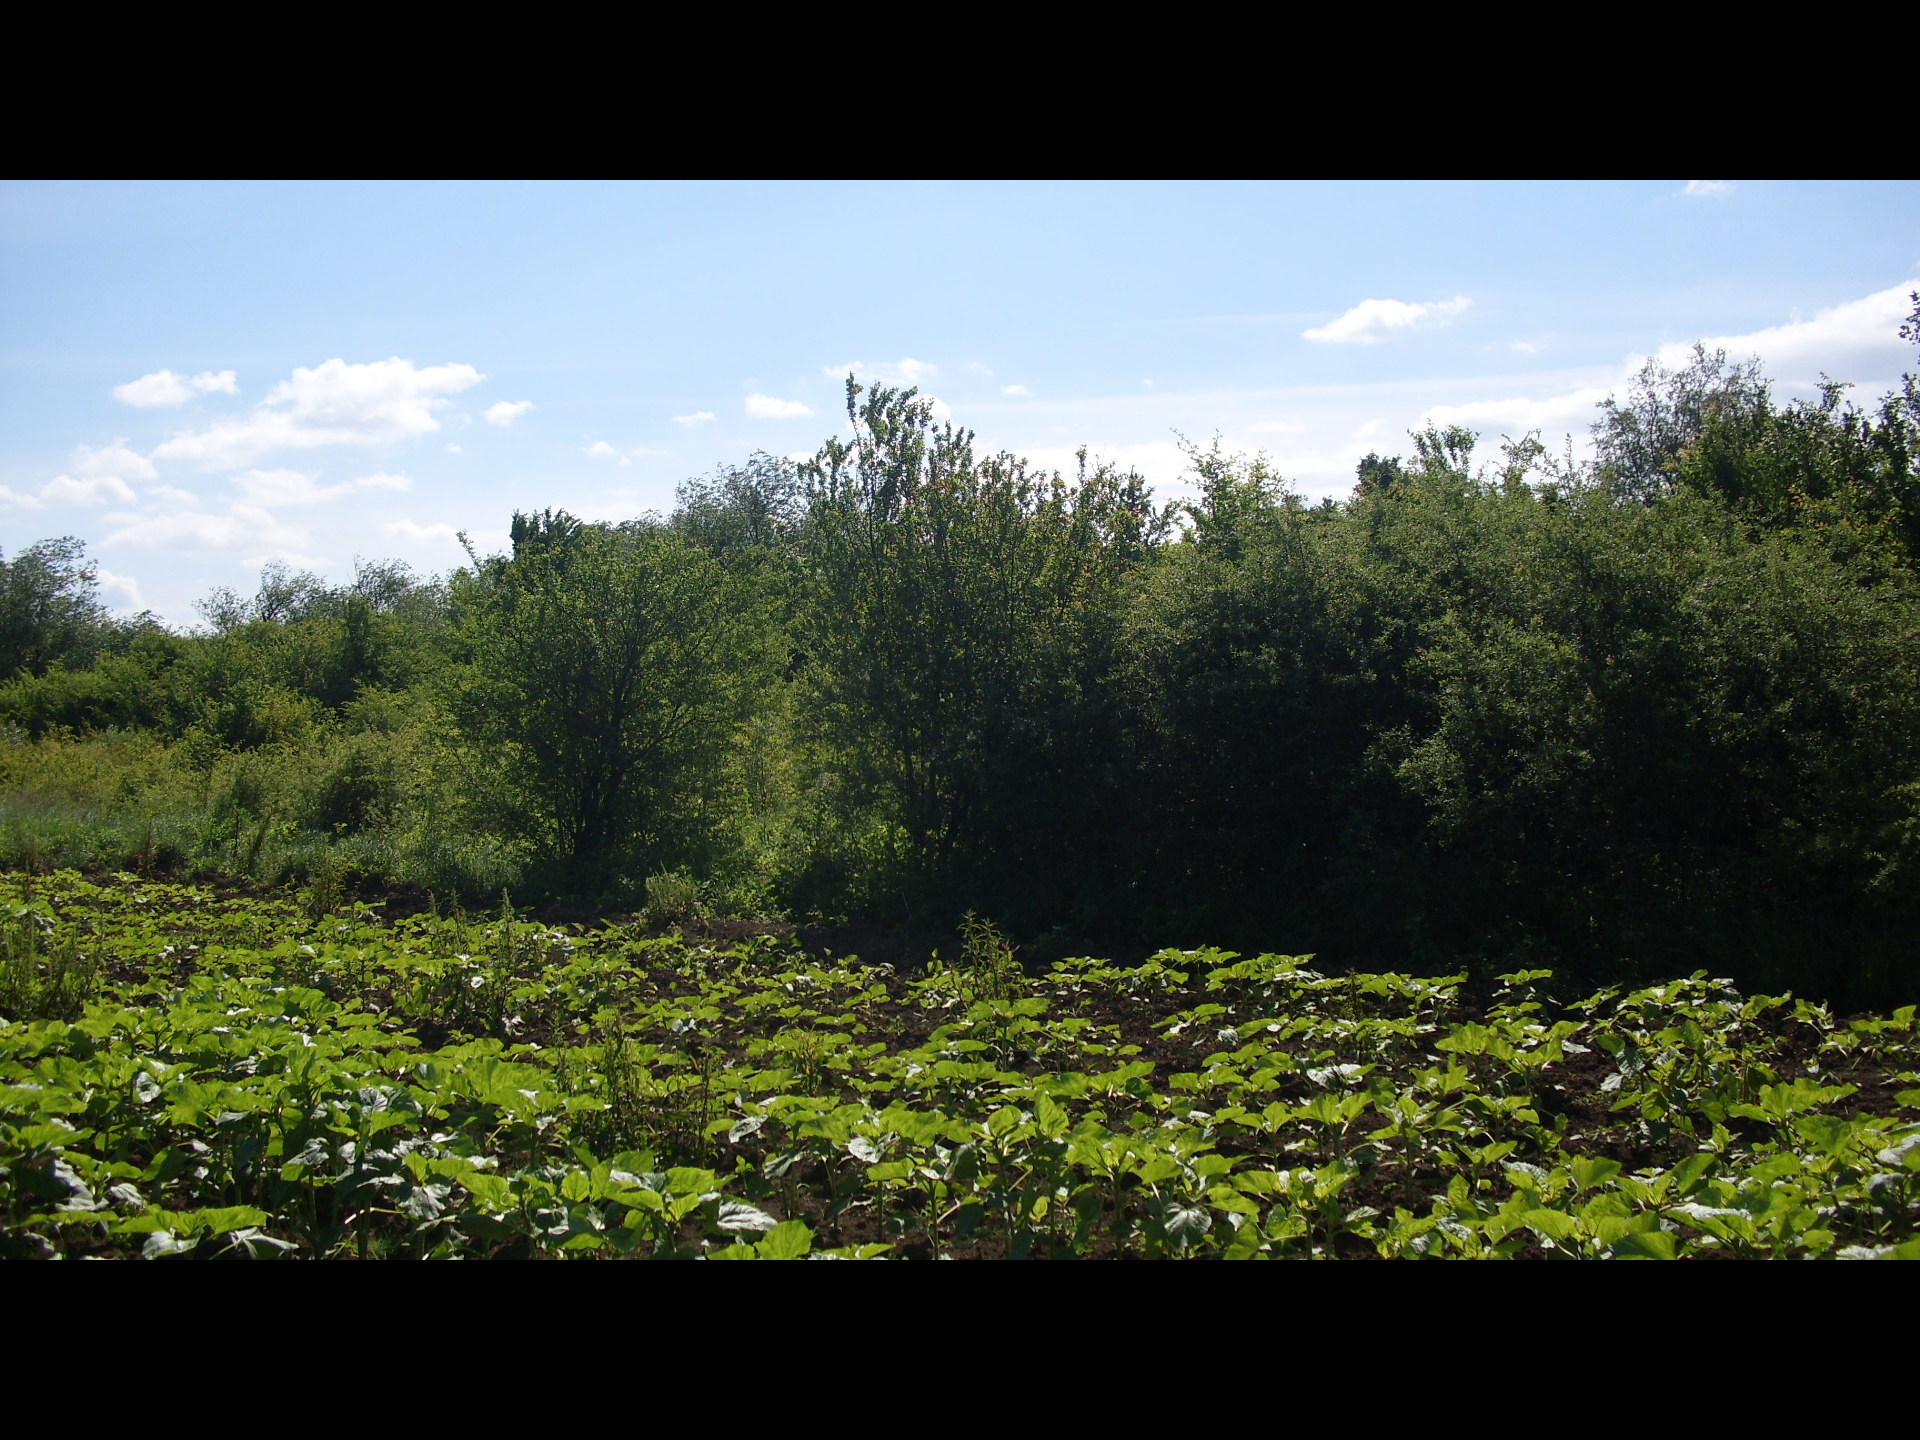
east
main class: Cropland
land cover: Sunflower
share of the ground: > 75 %
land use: Agriculture (excluding fallow land and kitchen gardens)
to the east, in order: Sunflower; Shrubland without tree cover; Broadleaved woodland; Rivers and streams; Broadleaved woodland; Shrubland without tree cover; Sunflower
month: May
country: BG
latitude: 43.3987
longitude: 23.4391
